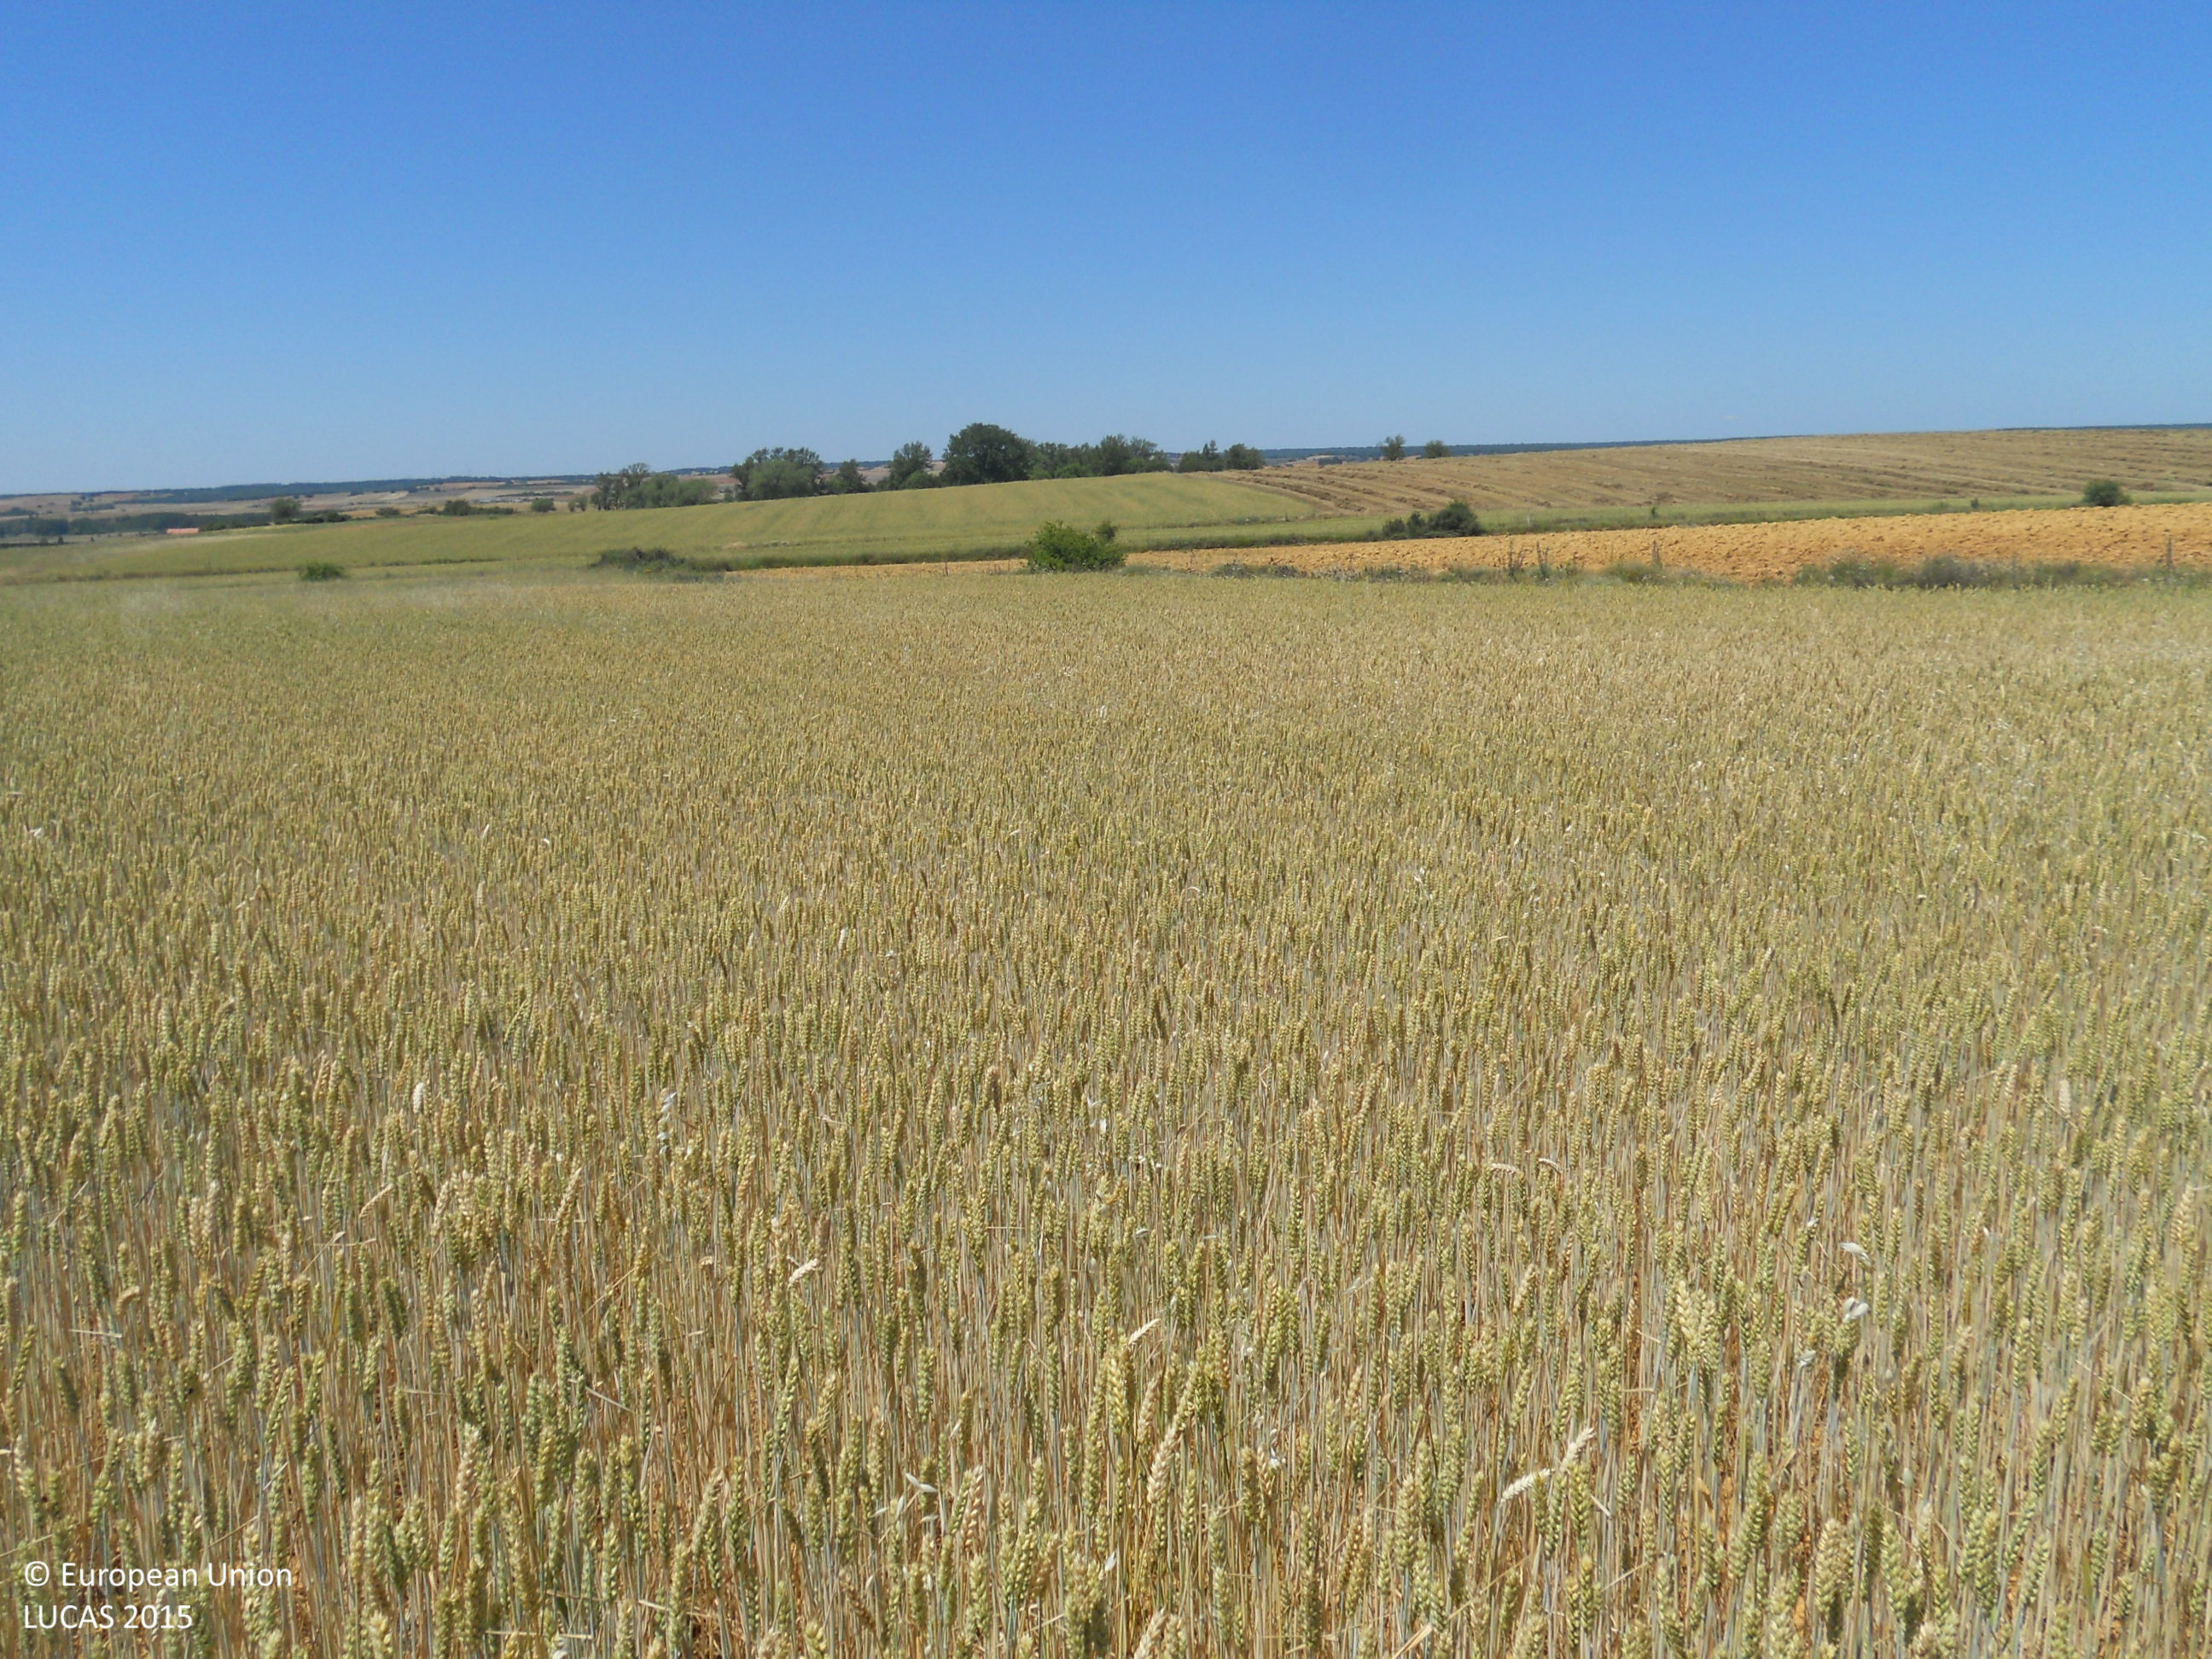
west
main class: Cropland
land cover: Common wheat
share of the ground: > 75 %
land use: Agriculture (excluding fallow land and kitchen gardens)
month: June
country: ES
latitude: 42.5734
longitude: -5.0095
